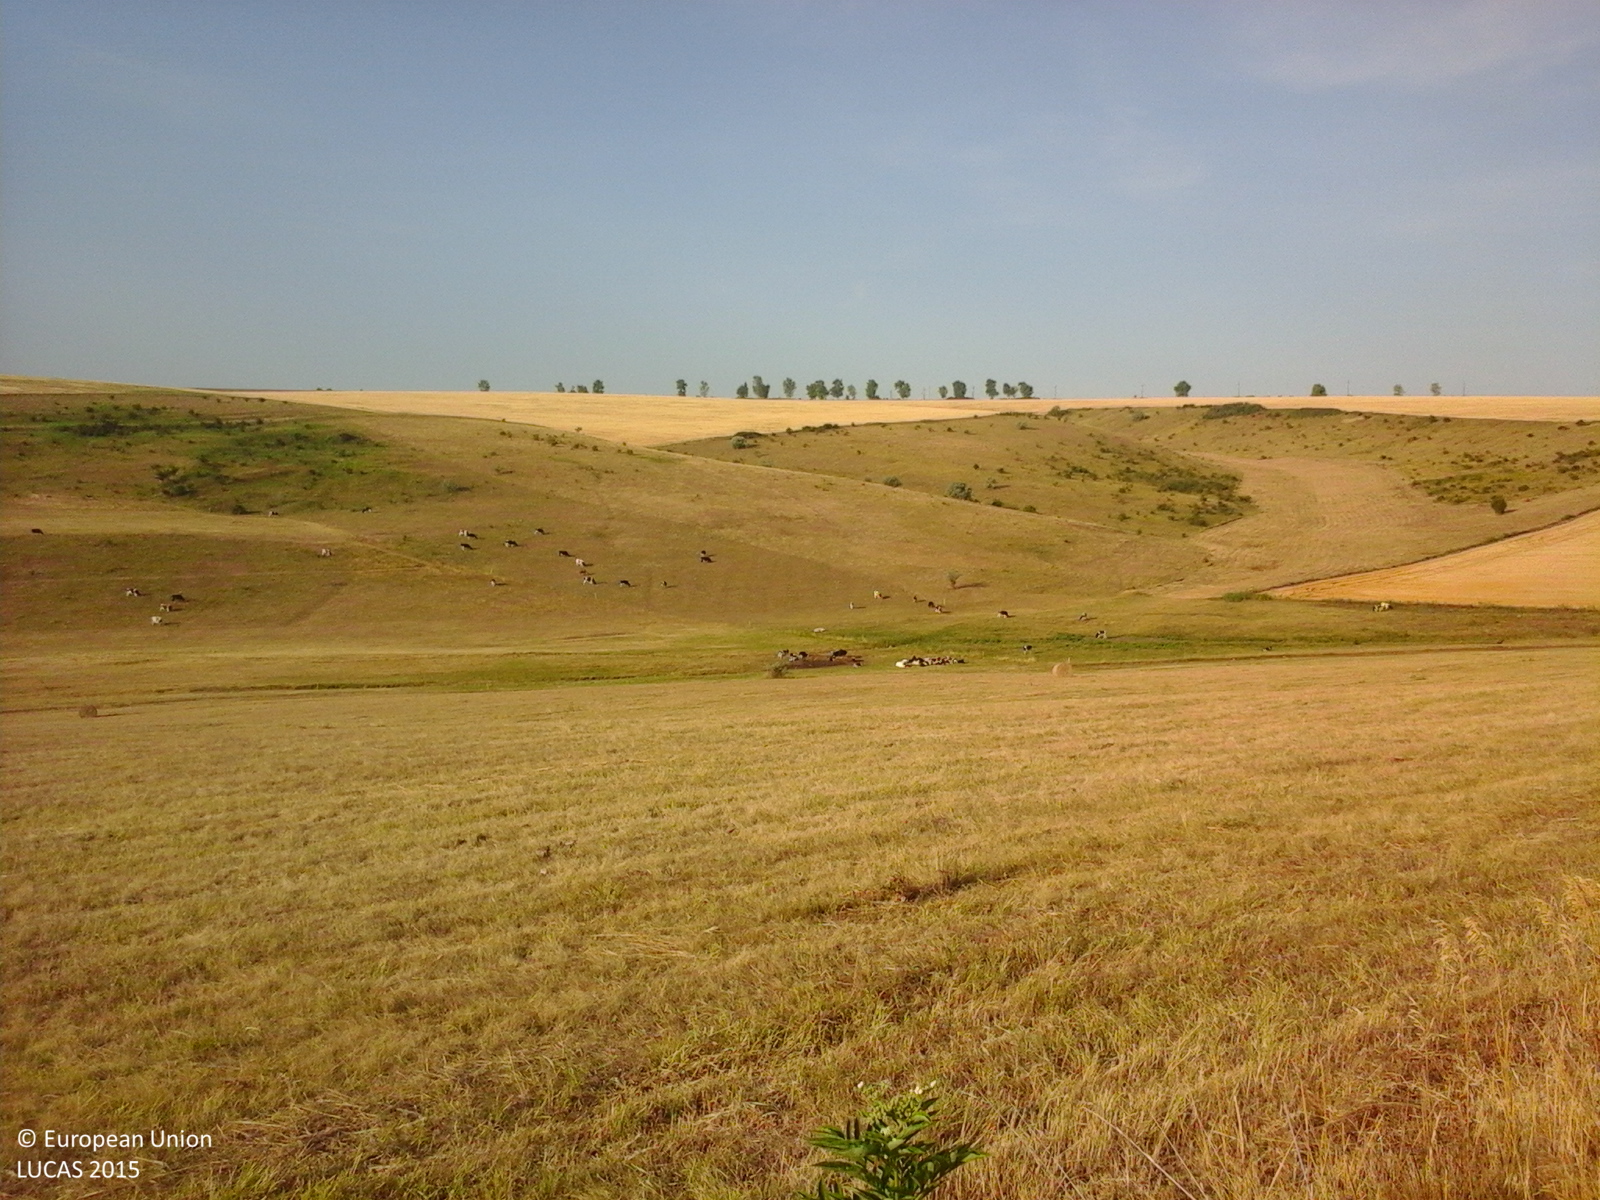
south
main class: Cropland
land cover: Sunflower
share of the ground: > 75 %
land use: Agriculture (excluding fallow land and kitchen gardens)
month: July
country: RO
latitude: 46.1964
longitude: 28.0736
